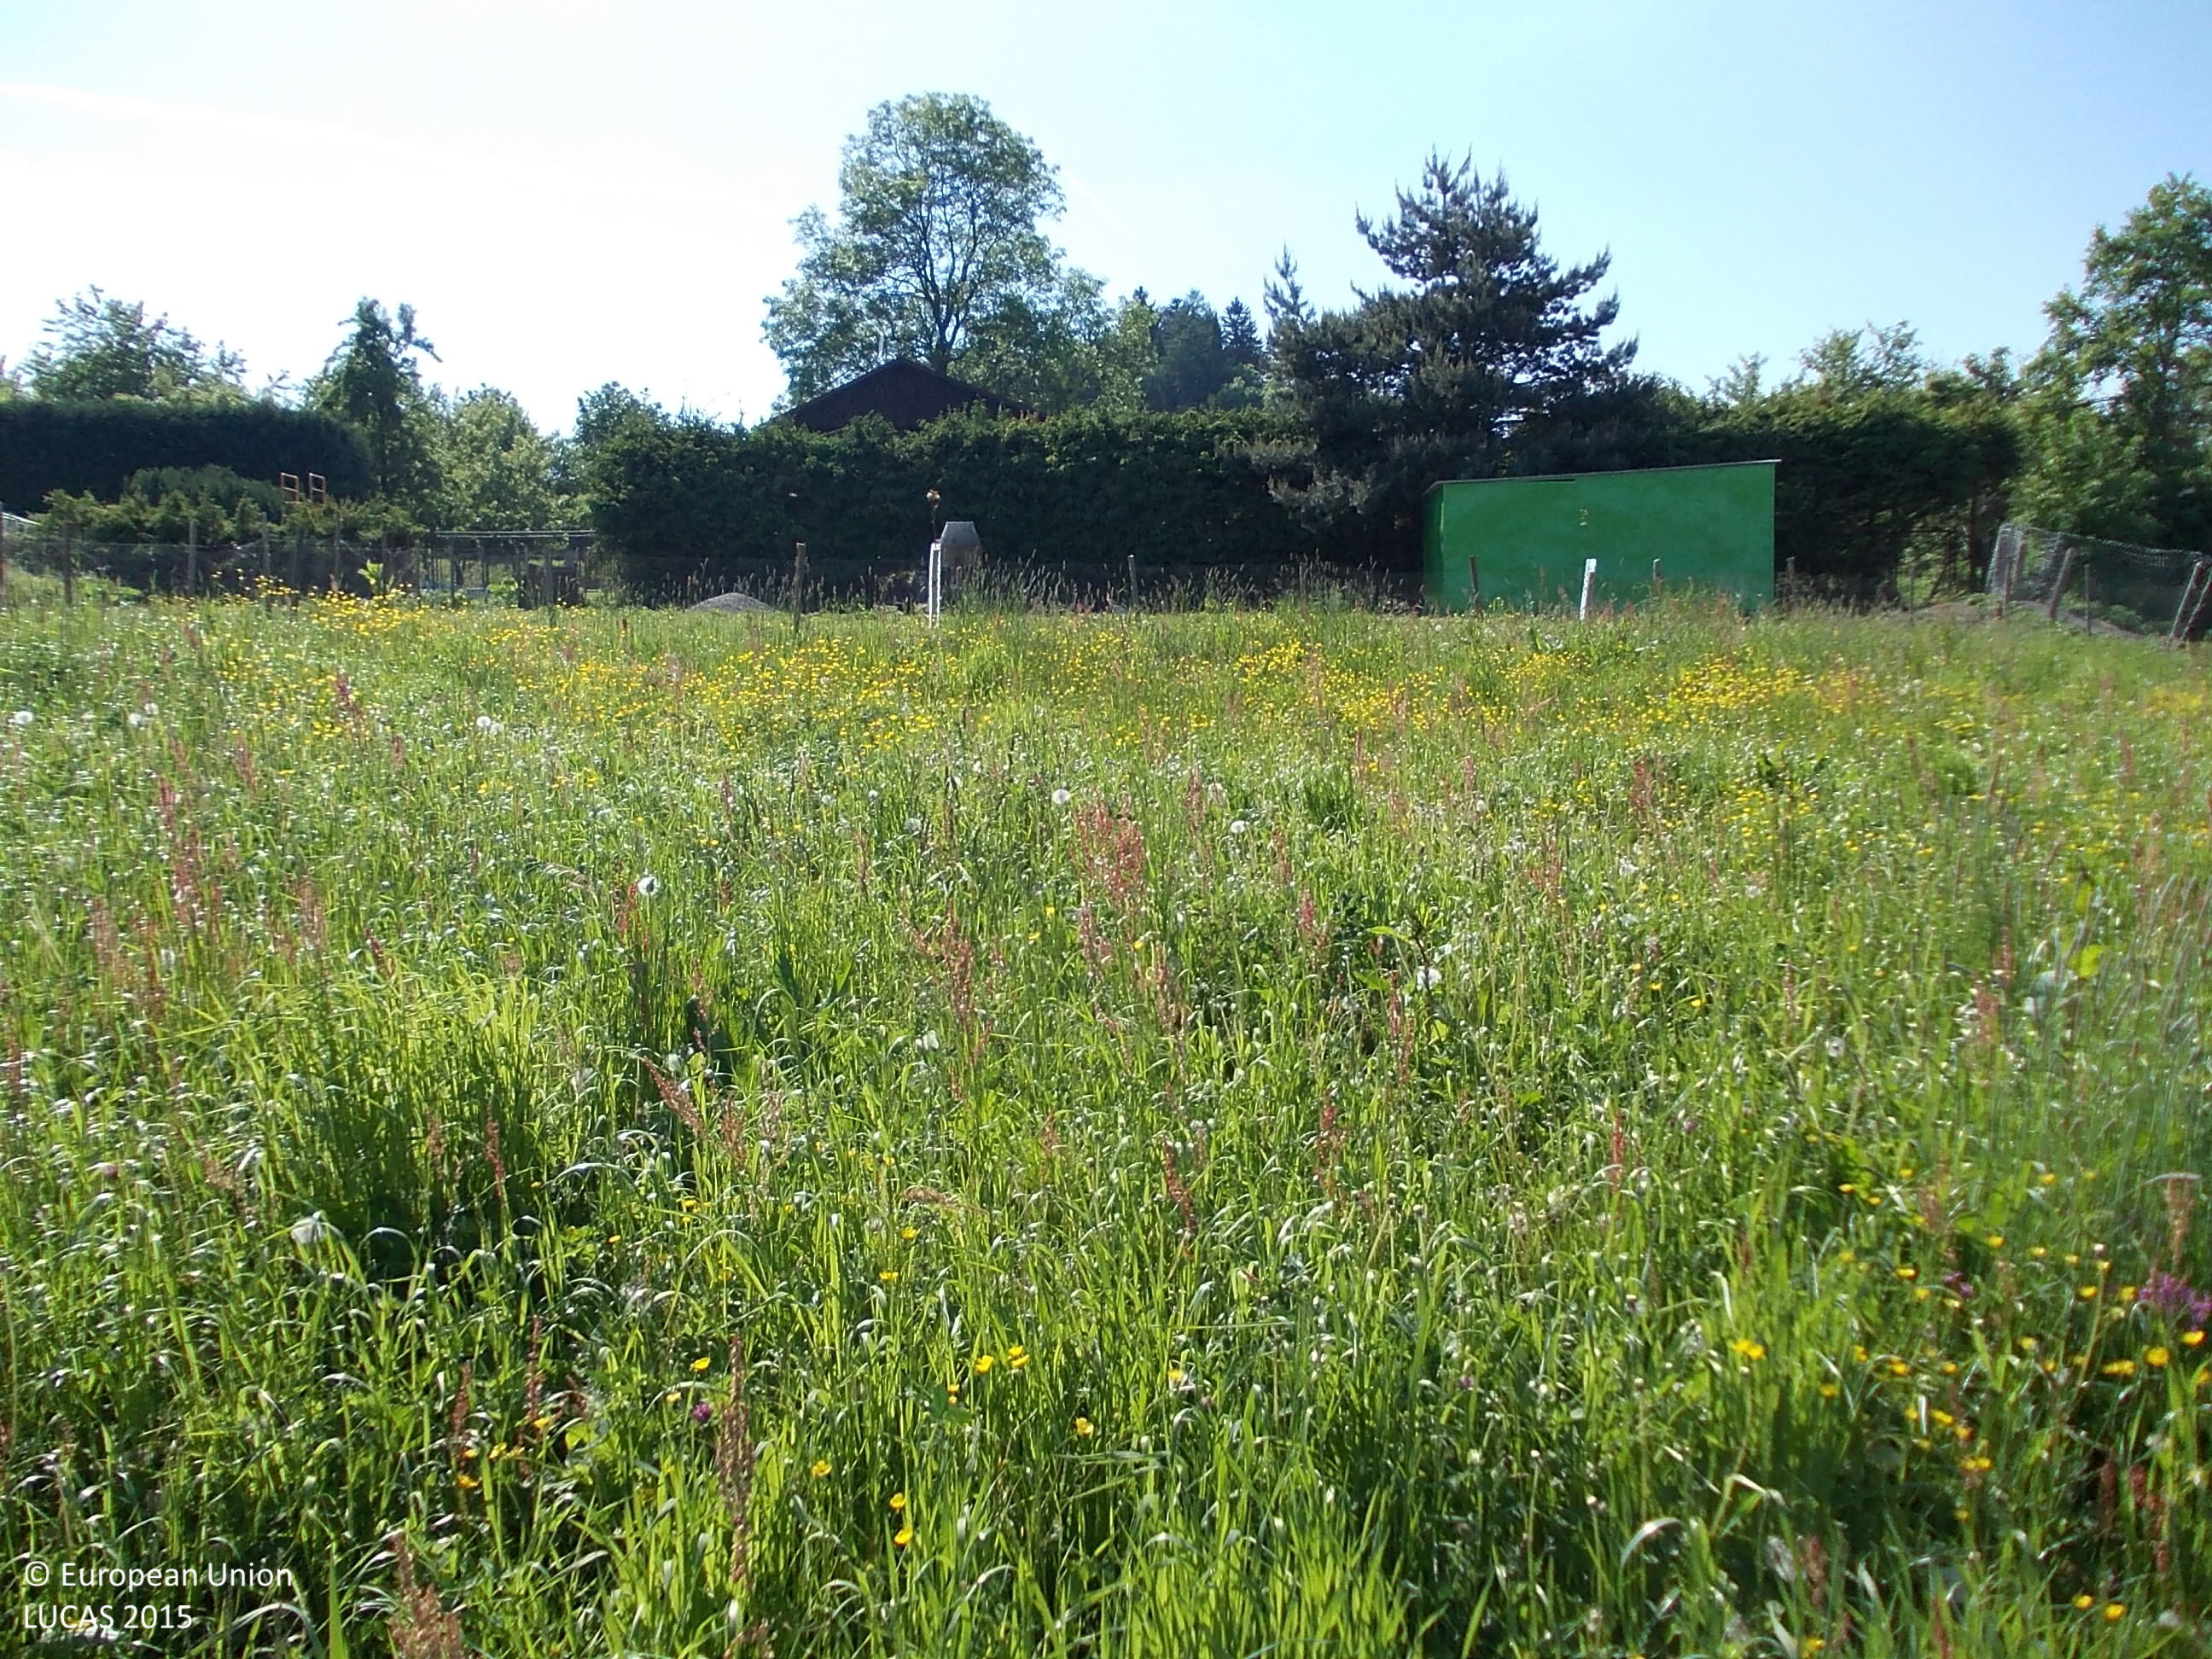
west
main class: Grassland
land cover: Grassland without tree/shrub cover
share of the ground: > 75 %
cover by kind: herbaceous plants 100 %
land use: Agriculture (excluding fallow land and kitchen gardens)
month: May
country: CZ
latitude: 49.2036
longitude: 13.7747
